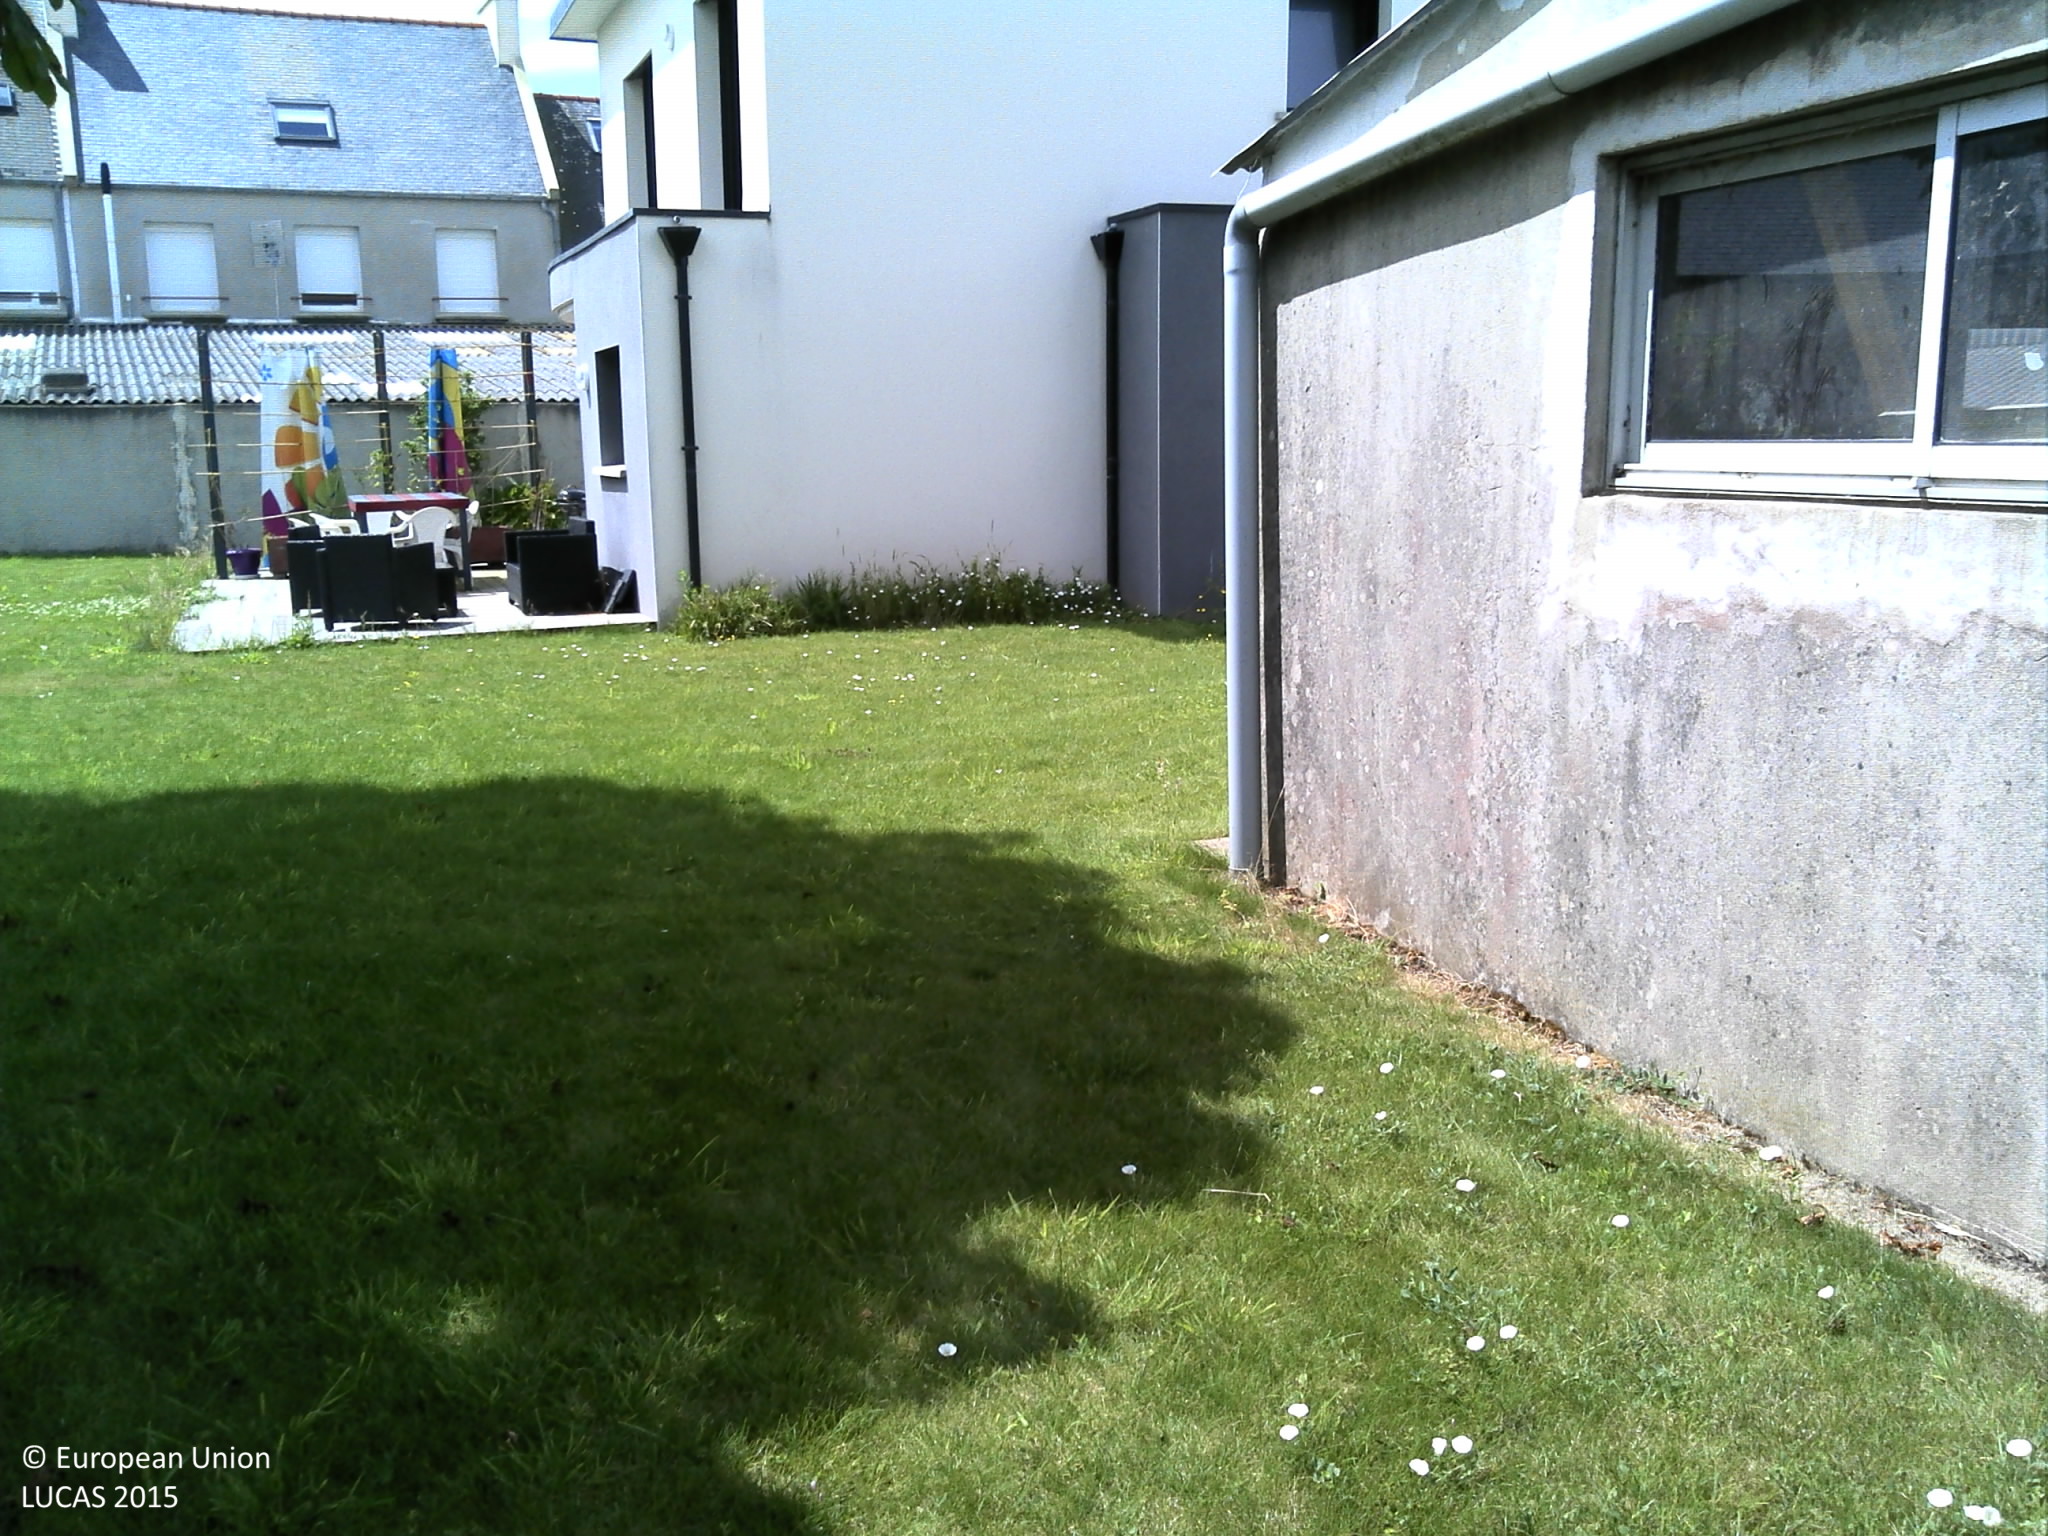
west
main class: Grassland
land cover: Grassland without tree/shrub cover
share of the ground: > 75 %
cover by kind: herbaceous plants 100 %
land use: Logistics and storage
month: July
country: FR
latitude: 48.5243
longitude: -4.6030
